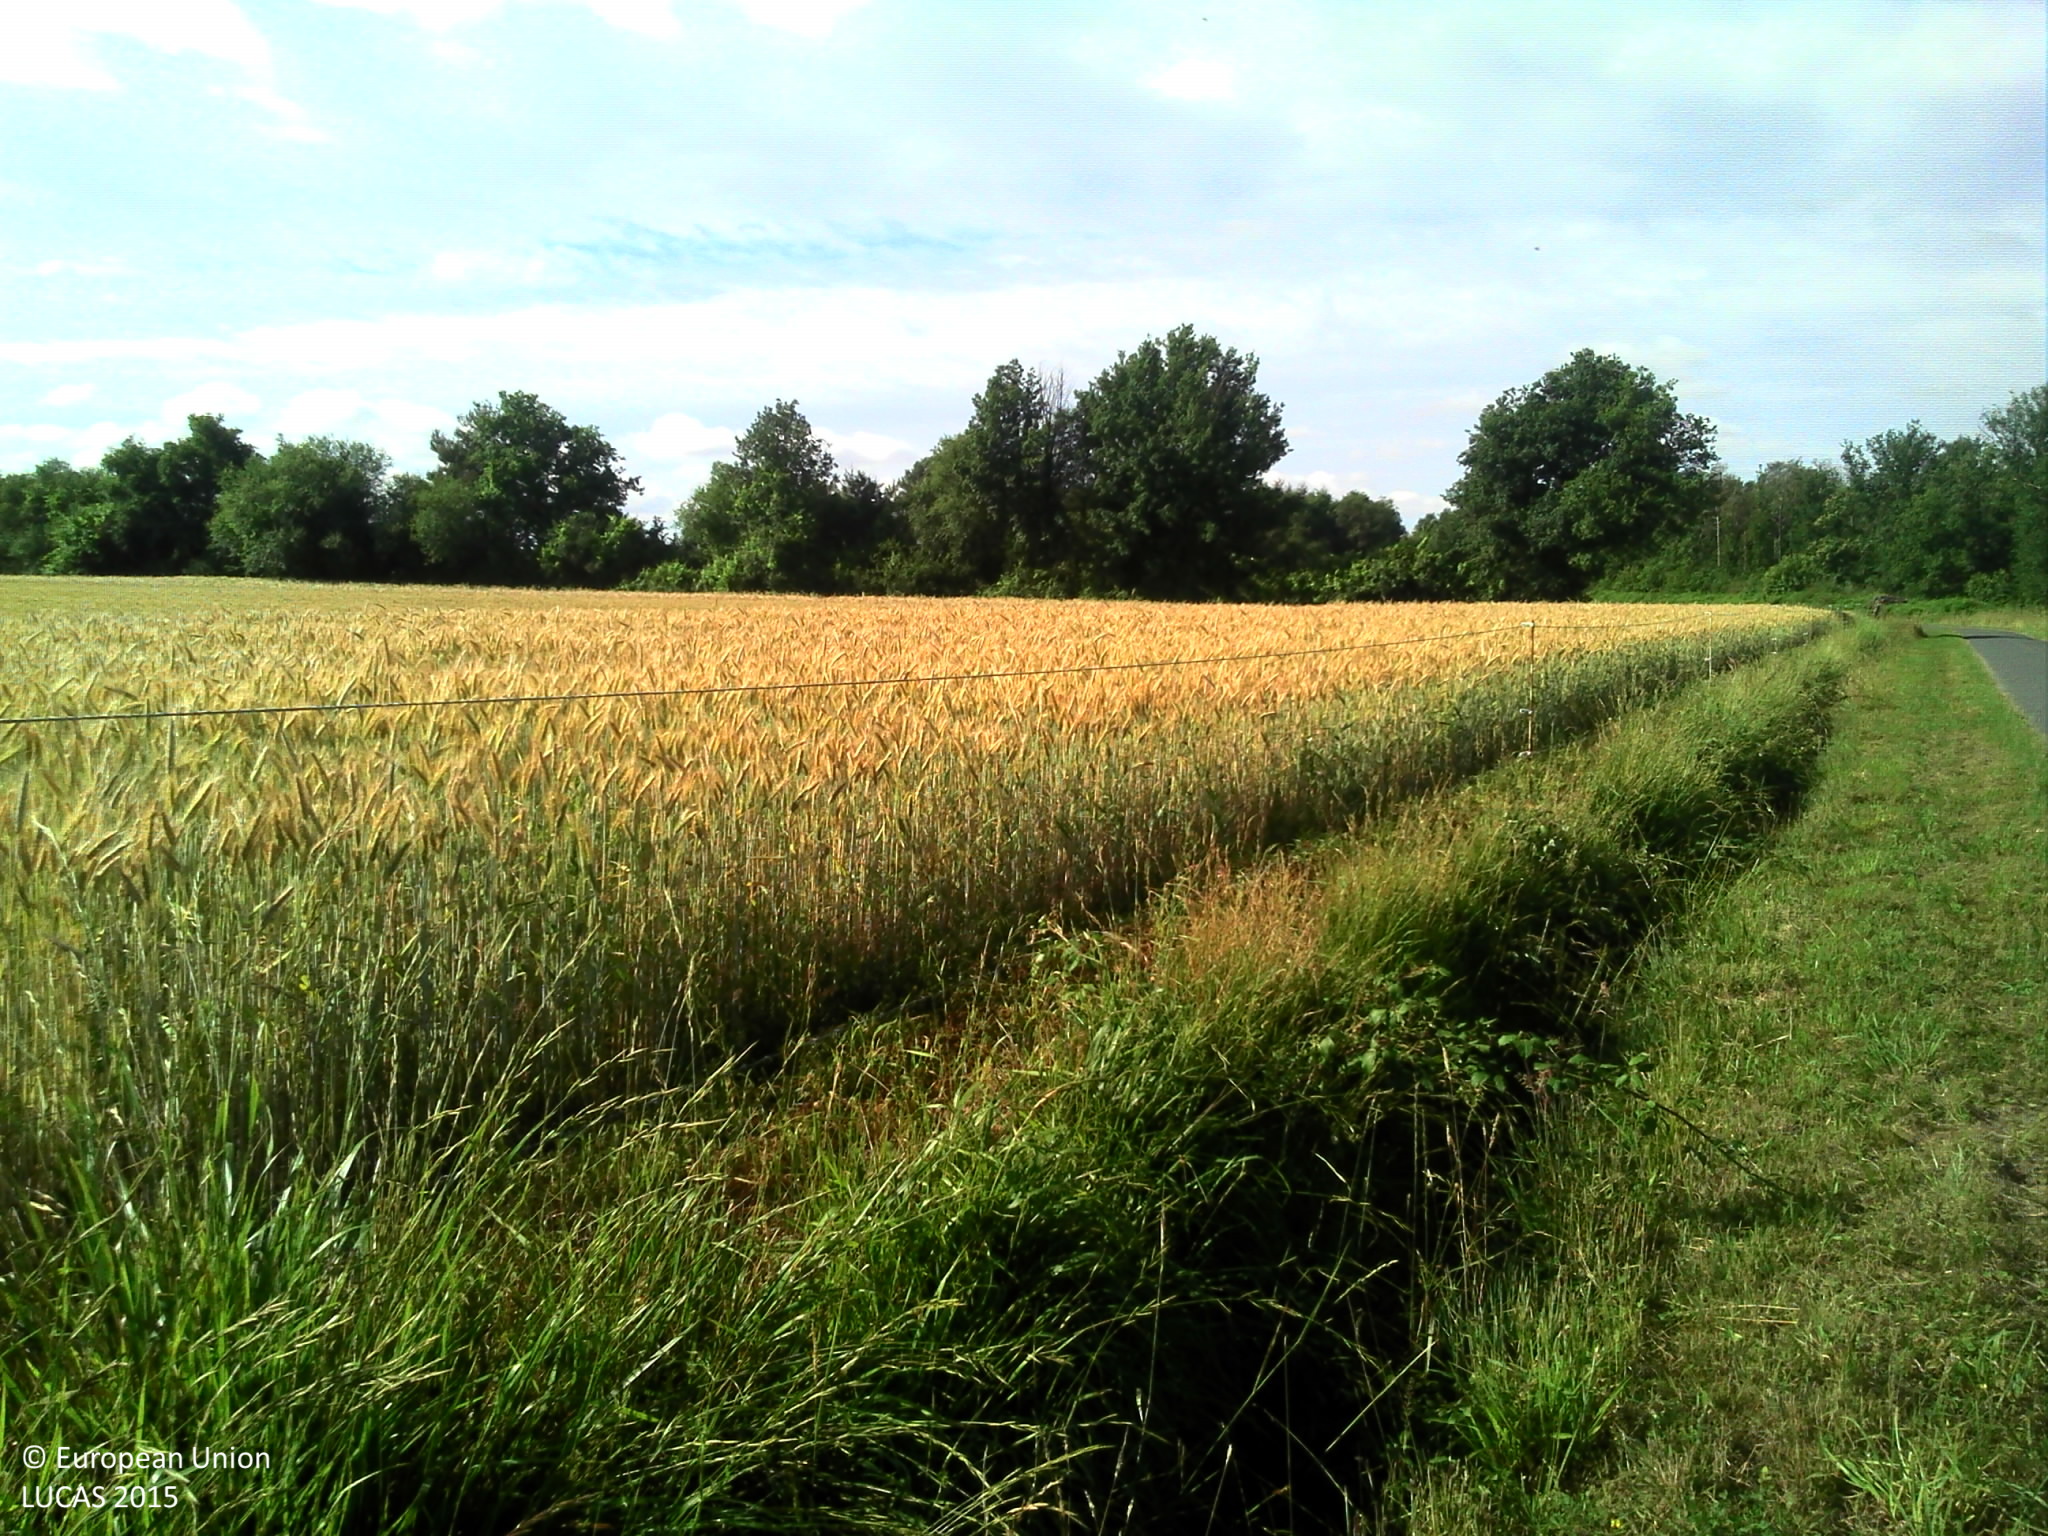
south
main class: Cropland
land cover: Durum wheat
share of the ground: > 75 %
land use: Agriculture (excluding fallow land and kitchen gardens)
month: June
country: FR
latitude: 46.6735
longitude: 0.5311
